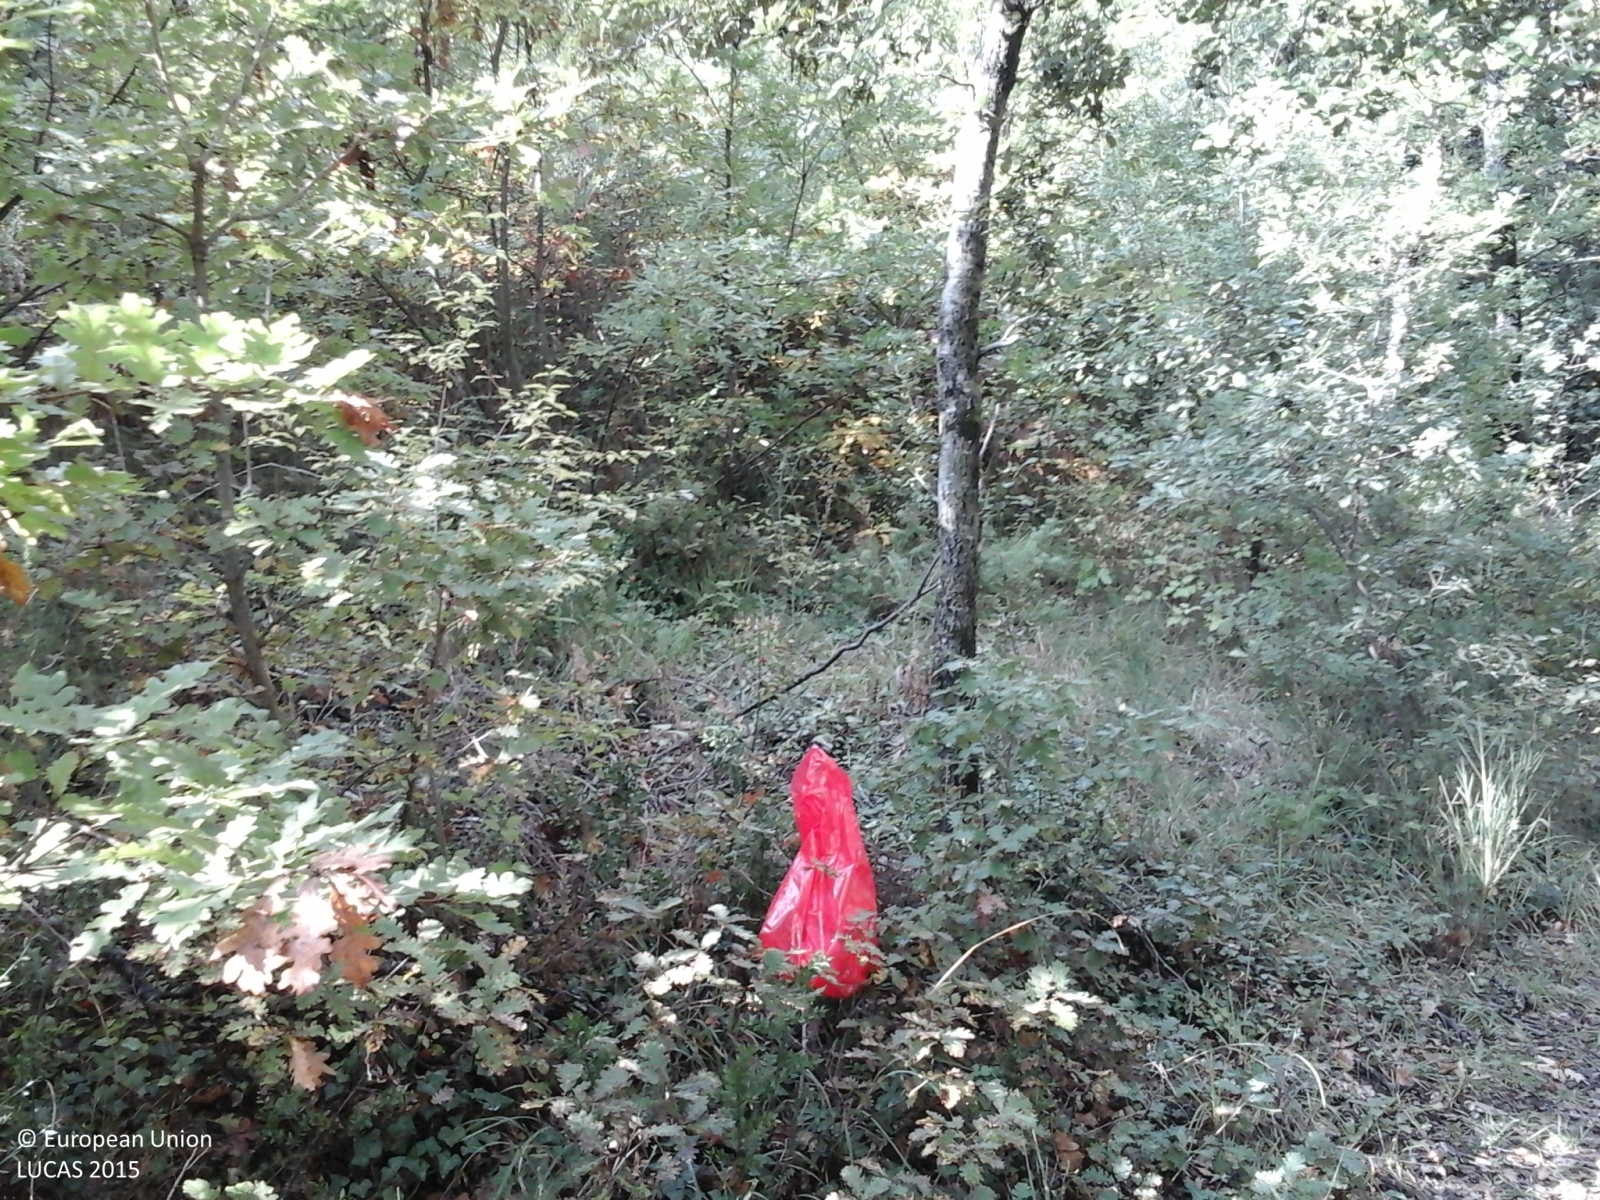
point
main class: Woodland
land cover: Broadleaved woodland
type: thermophilous deciduous forest
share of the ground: > 75 %
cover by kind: broadleaved forest trees 100 %
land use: Forestry
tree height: > 5 m
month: October
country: IT
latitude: 42.7666
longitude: 12.5462
